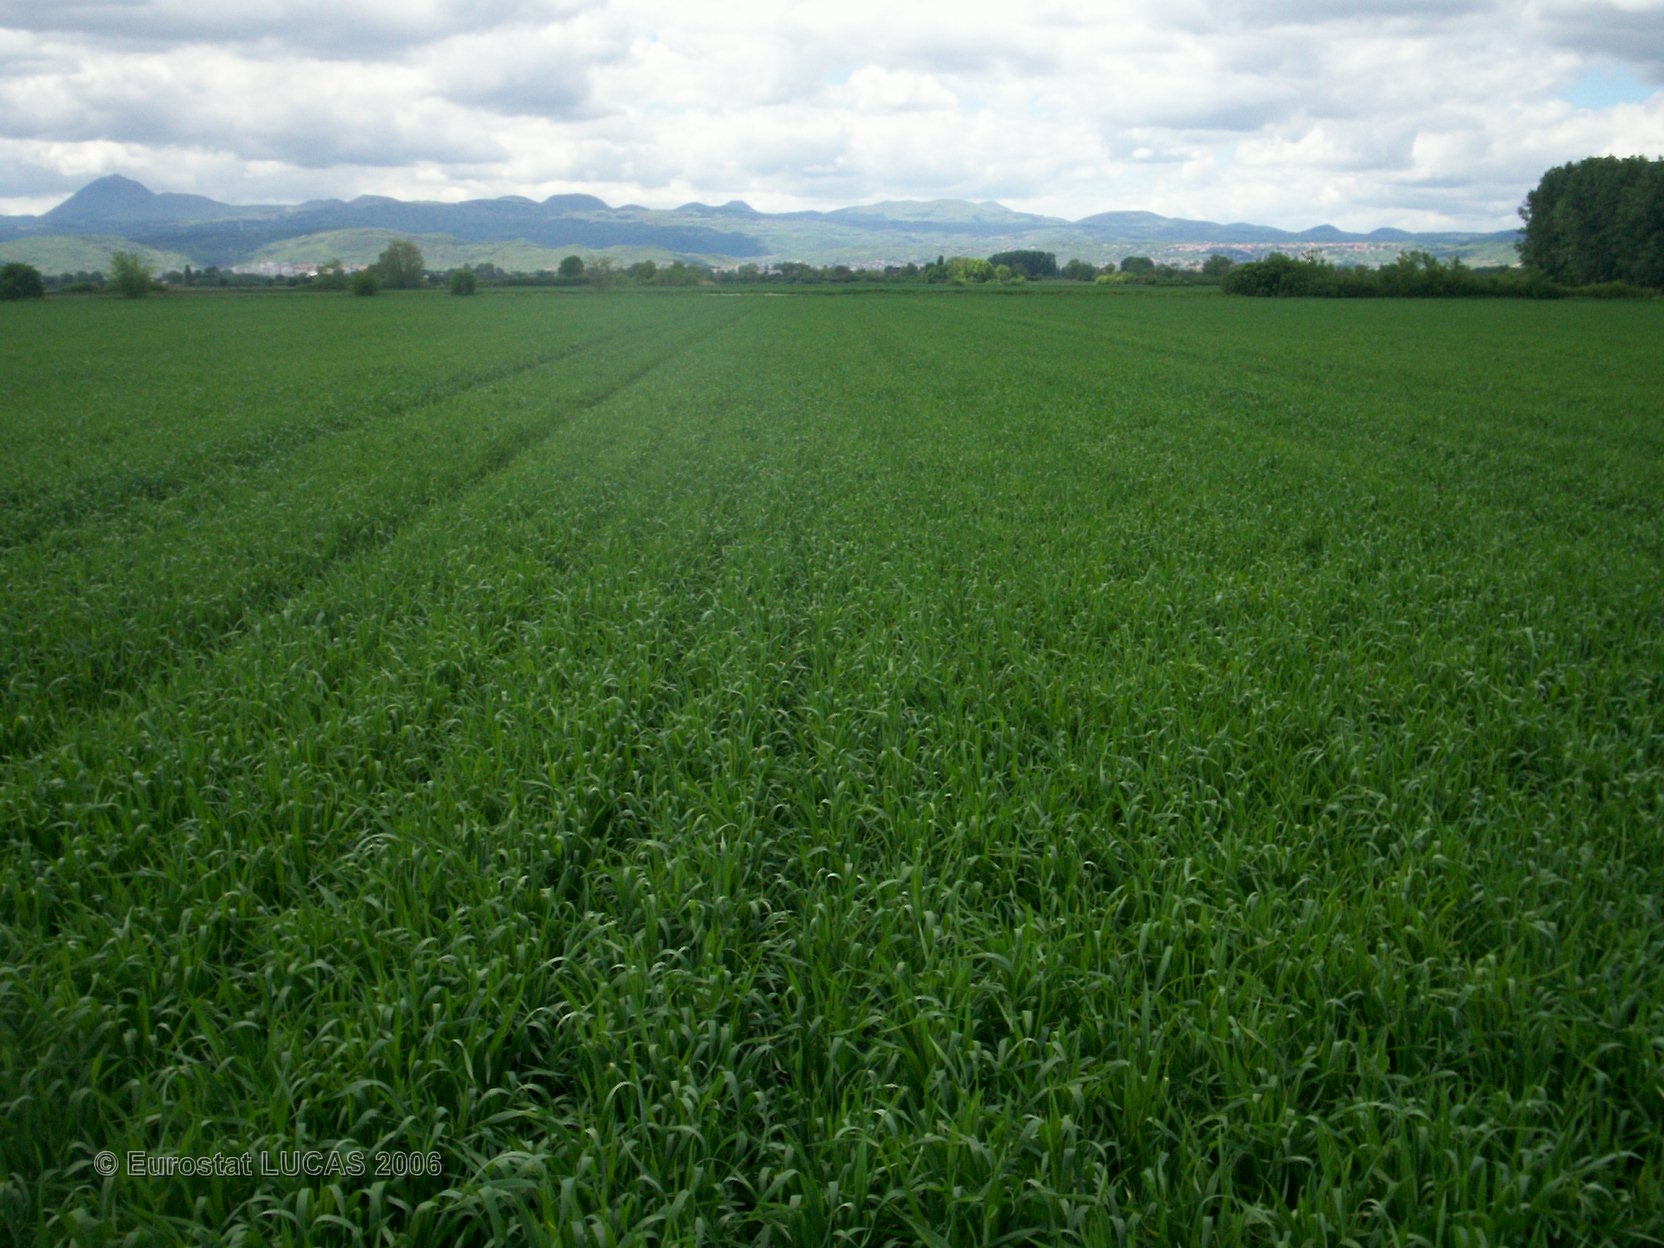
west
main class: Cropland
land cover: Common wheat
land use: Agriculture (excluding fallow land and kitchen gardens)
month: May
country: FR
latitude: 45.8268
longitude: 3.1904
